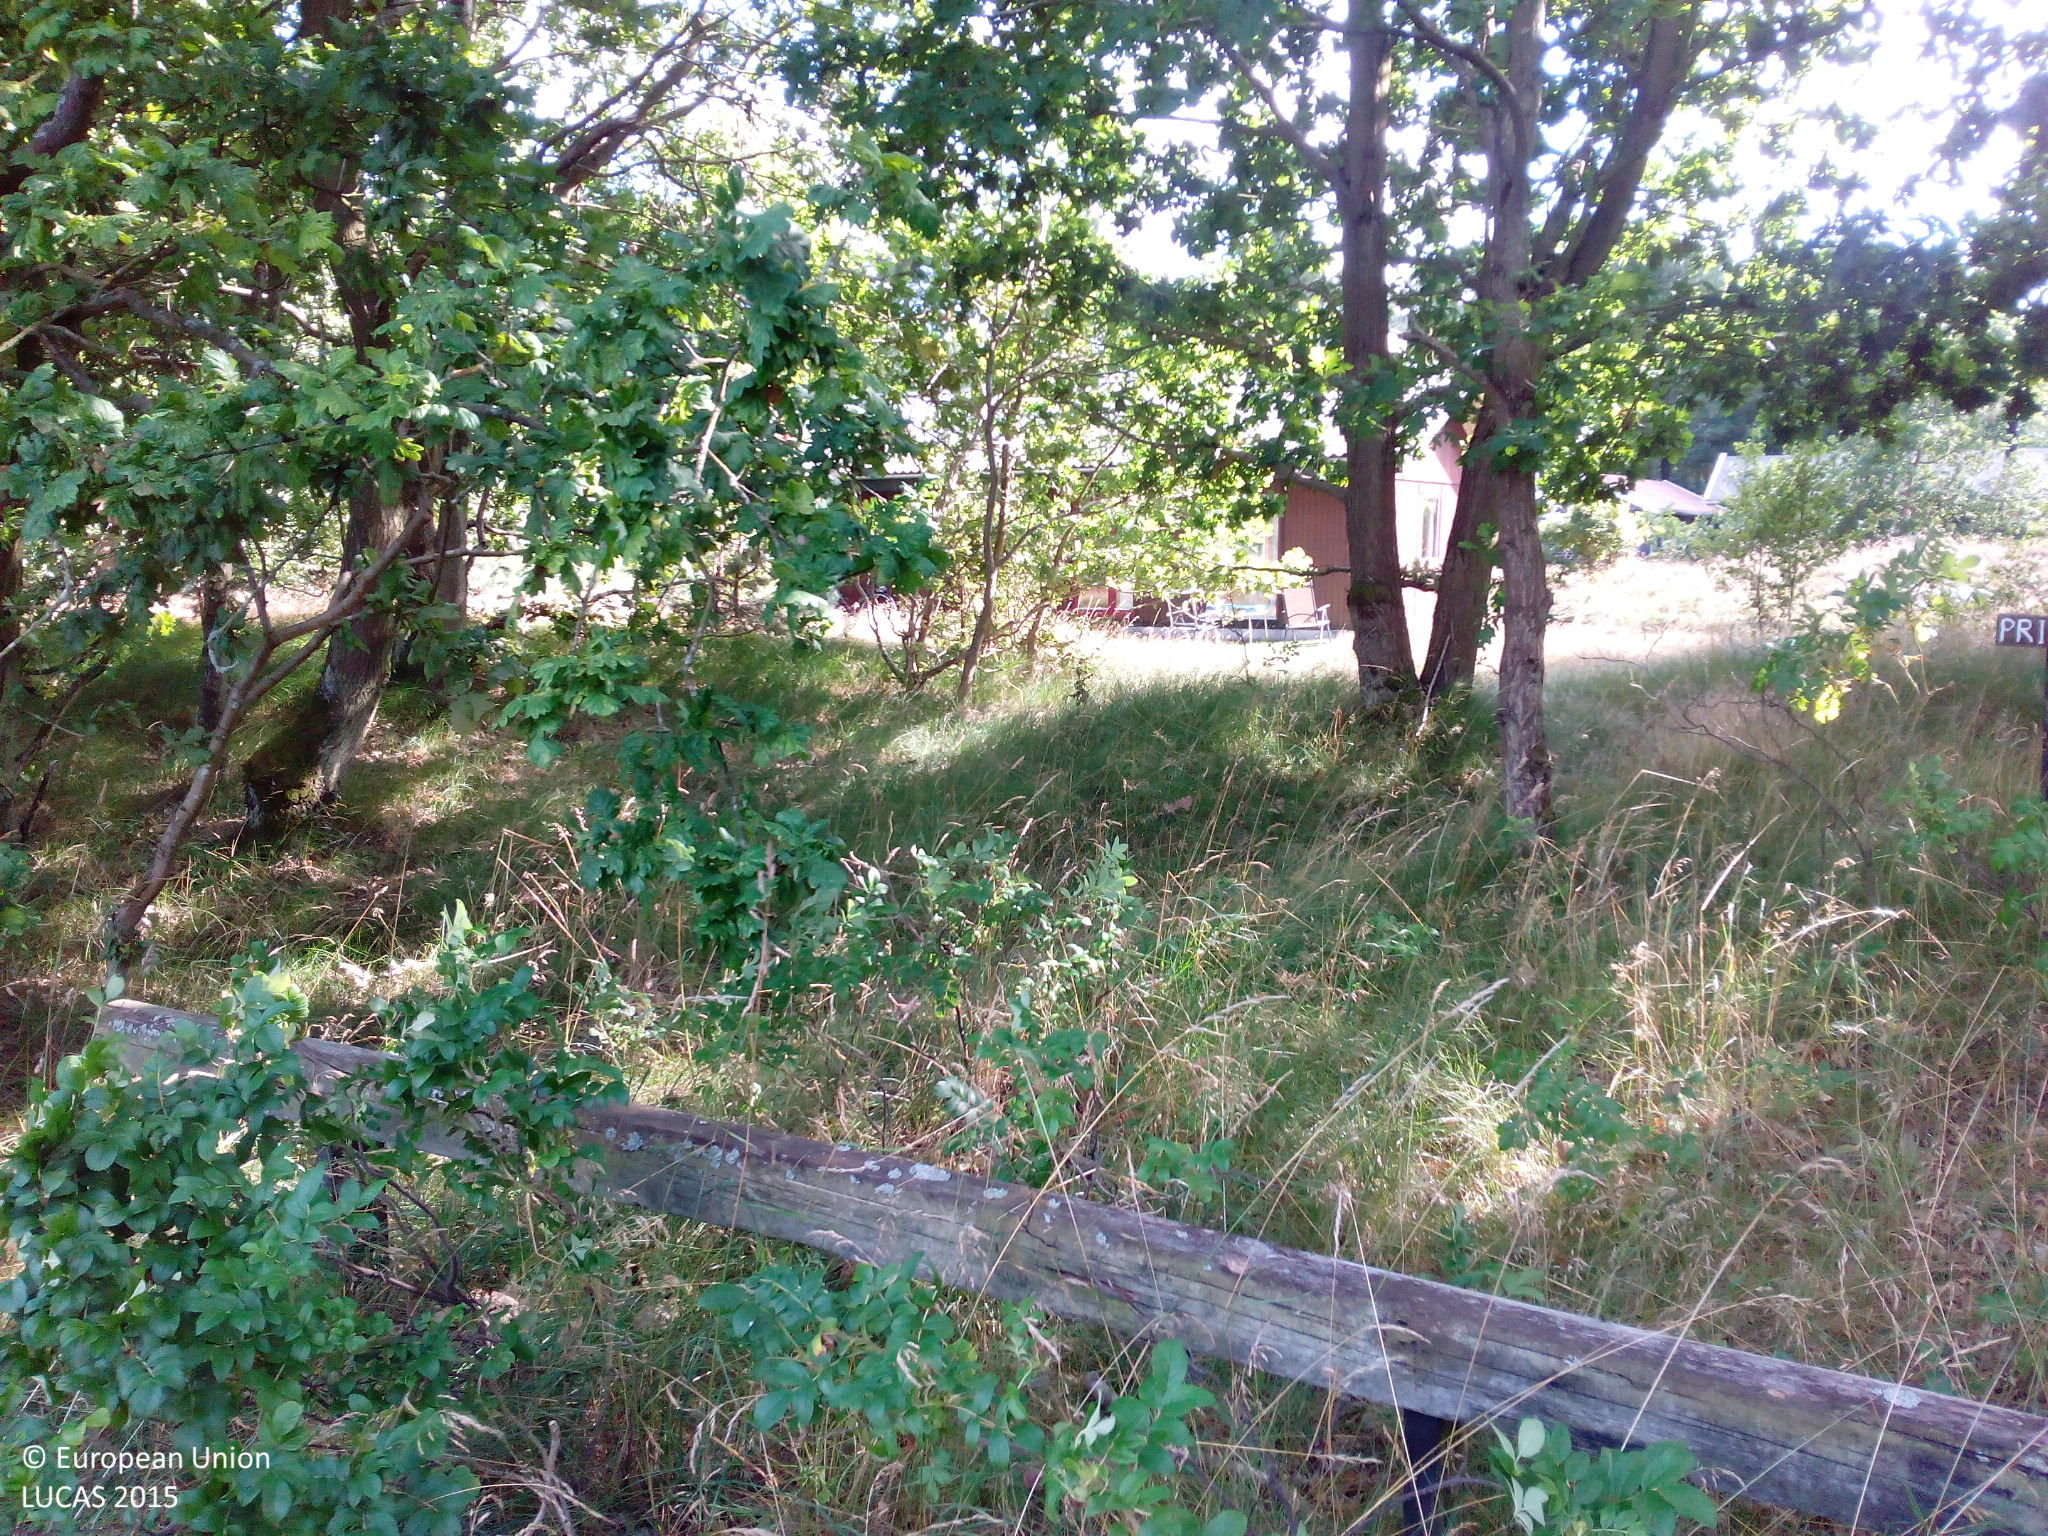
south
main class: Grassland
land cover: Grassland with sparse tree/shrub cover
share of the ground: > 75 %
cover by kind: herbaceous plants 95 %, broadleaved forest trees 5 %
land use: Residential
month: August
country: DK
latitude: 55.0101
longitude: 14.9887
